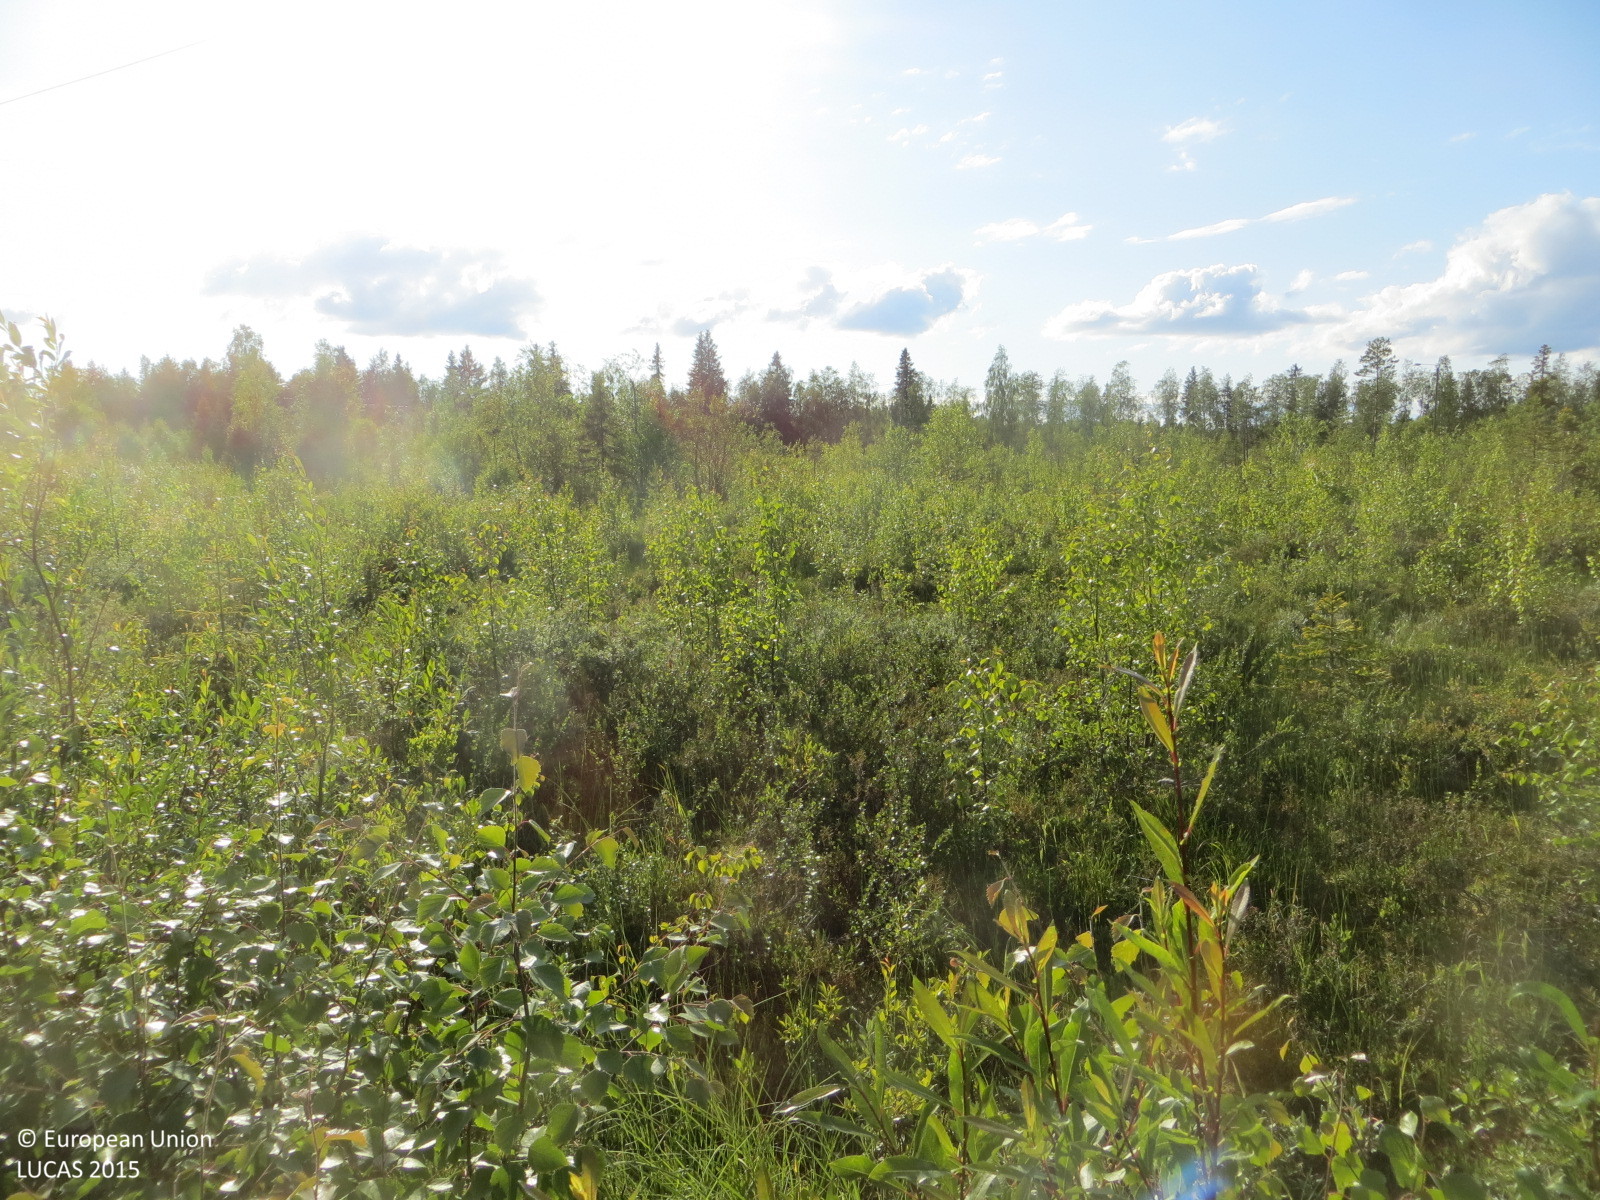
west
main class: Shrubland
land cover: Shrubland with sparse tree cover
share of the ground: > 75 %
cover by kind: shrubs 55 %, lichens and mosses 40 %, broadleaved forest trees 5 %
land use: Electricity, gas and thermal power distribution
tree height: < 5 m
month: July
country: FI
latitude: 65.9610
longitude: 24.0579
